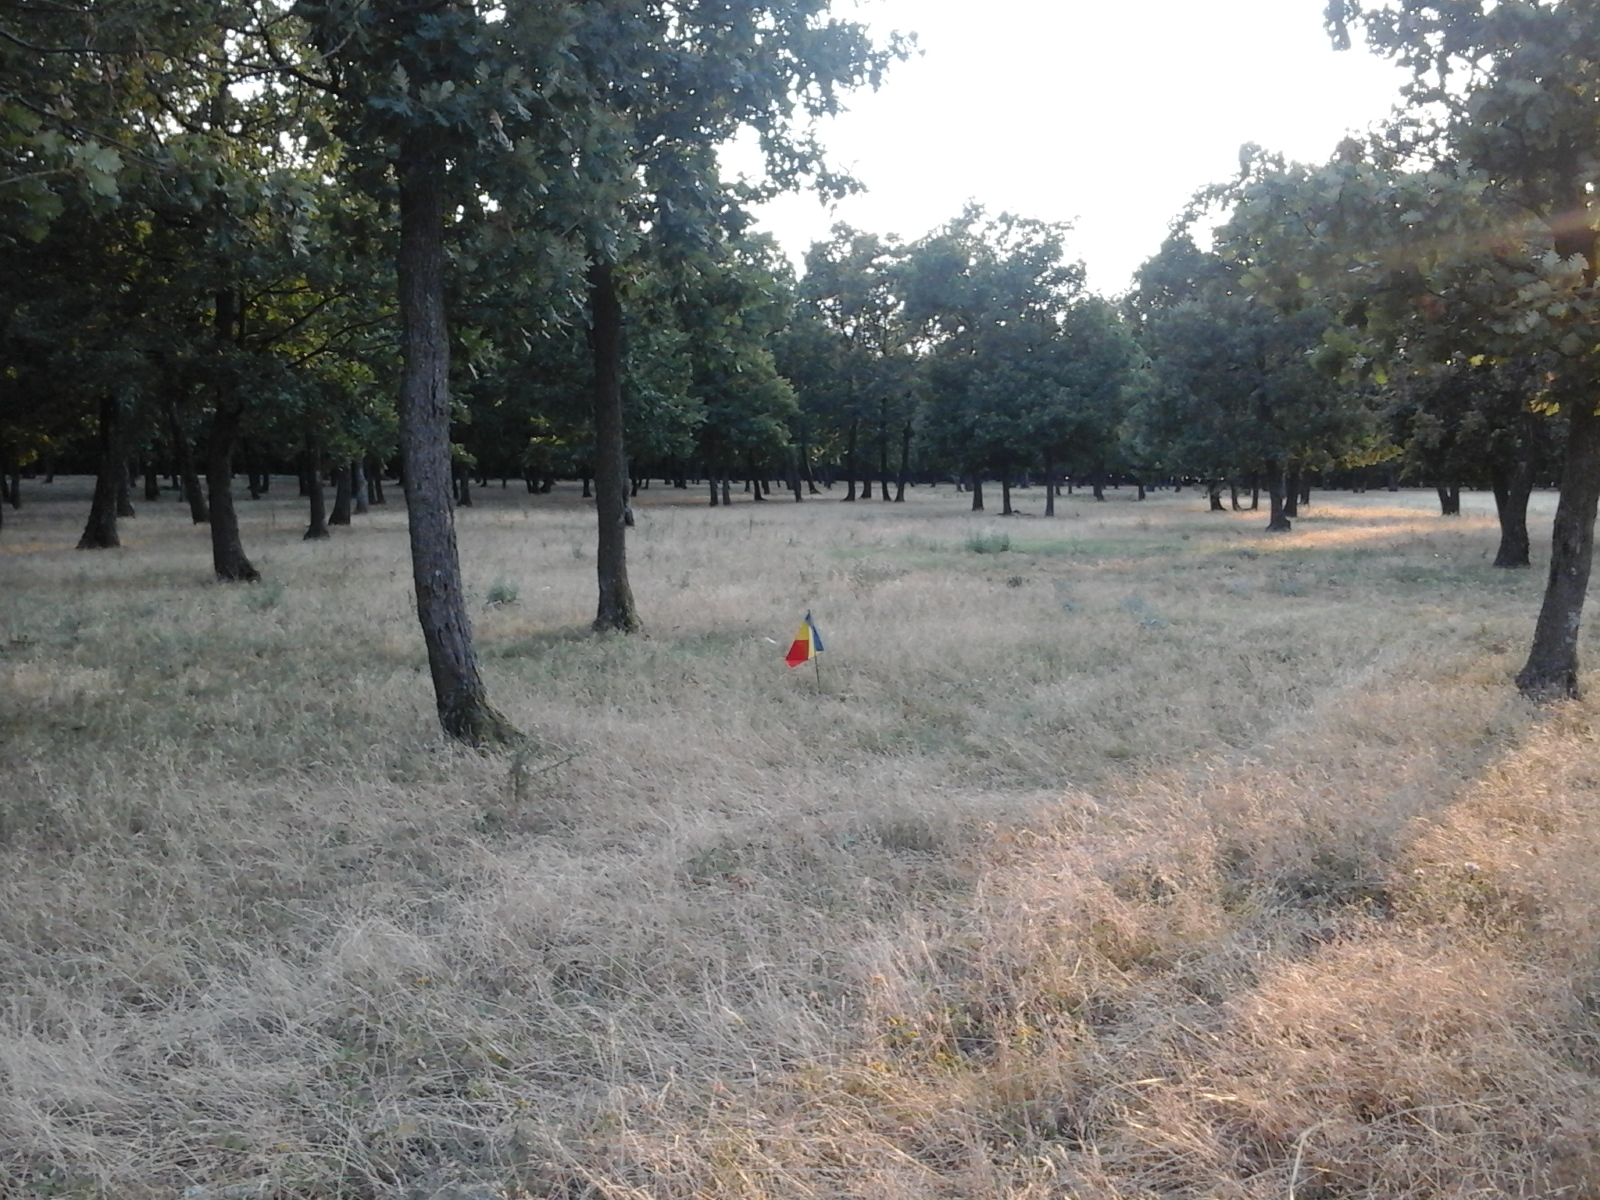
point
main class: Woodland
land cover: Broadleaved woodland
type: acidophilous oak and oak-birch forest
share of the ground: > 75 %
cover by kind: broadleaved forest trees 100 %
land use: Forestry
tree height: > 5 m
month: August
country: RO
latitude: 44.1636
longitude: 23.3157
